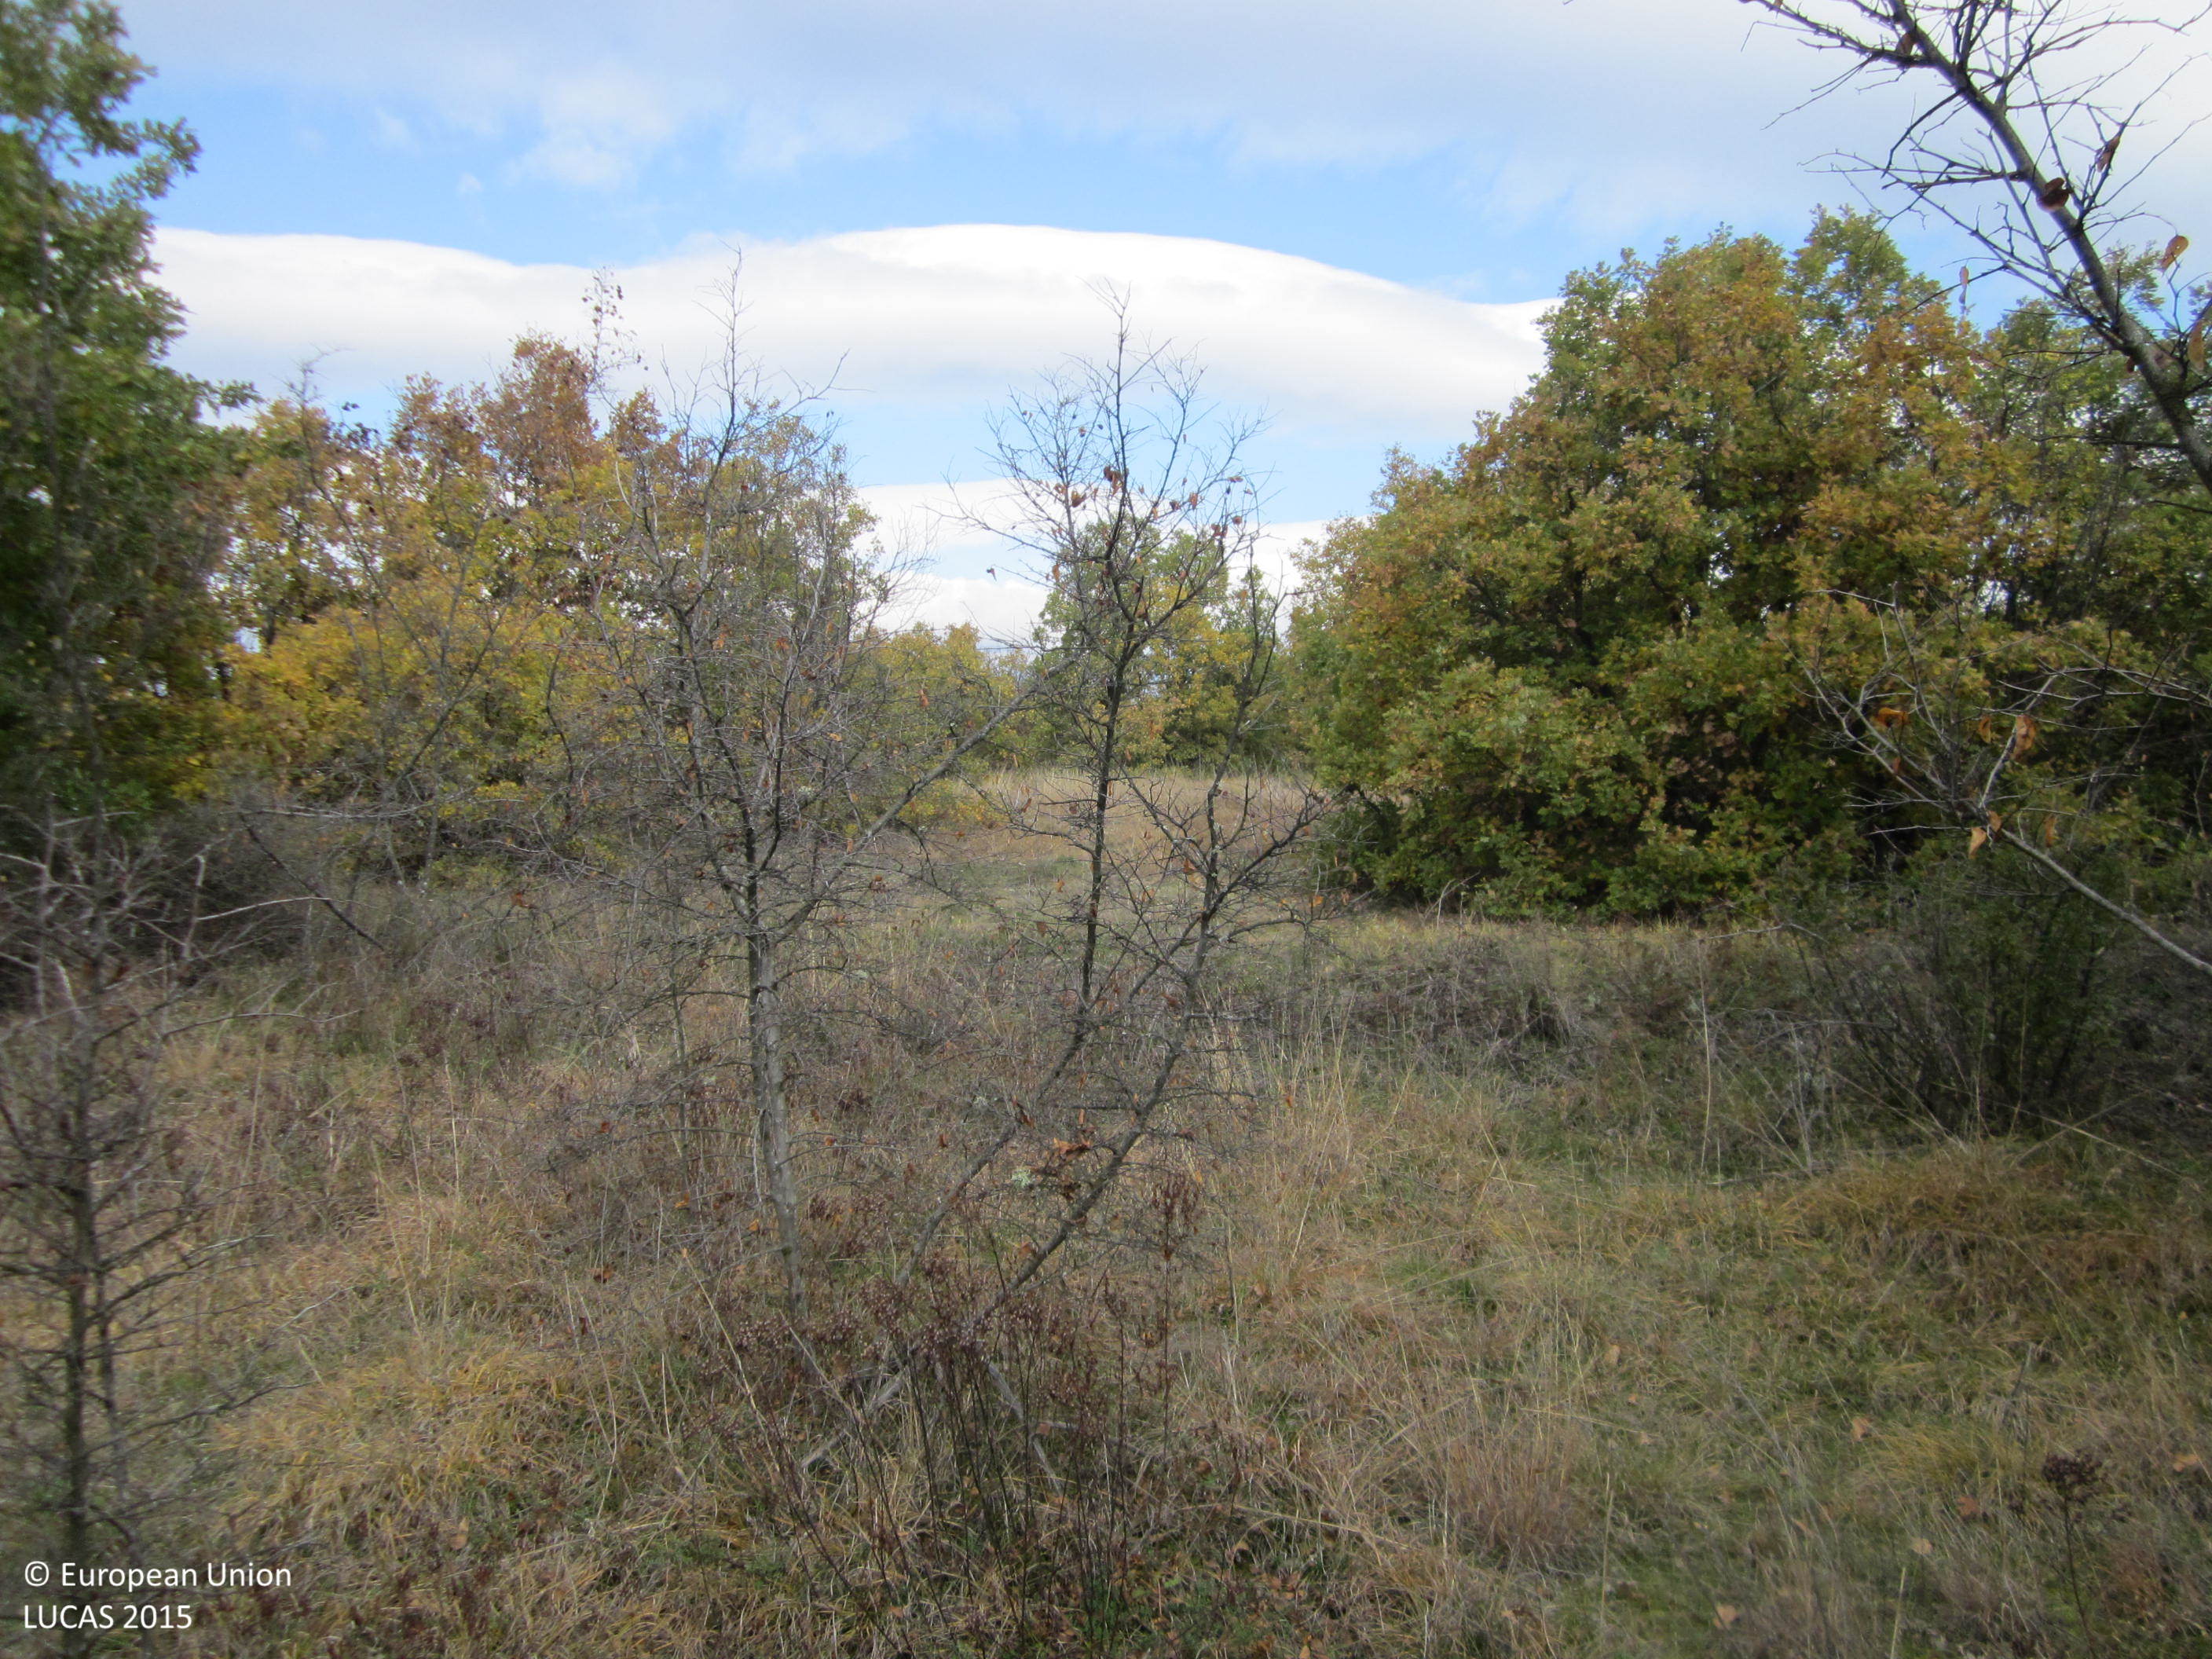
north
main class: Woodland
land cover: Broadleaved woodland
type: mesophytic deciduous forest
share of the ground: > 75 %
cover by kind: broadleaved forest trees 90 %, shrubs 5 %, unconsolidated bare surface 5 %
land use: Forestry
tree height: > 5 m
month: November
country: BG
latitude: 42.5594
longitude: 24.8570
